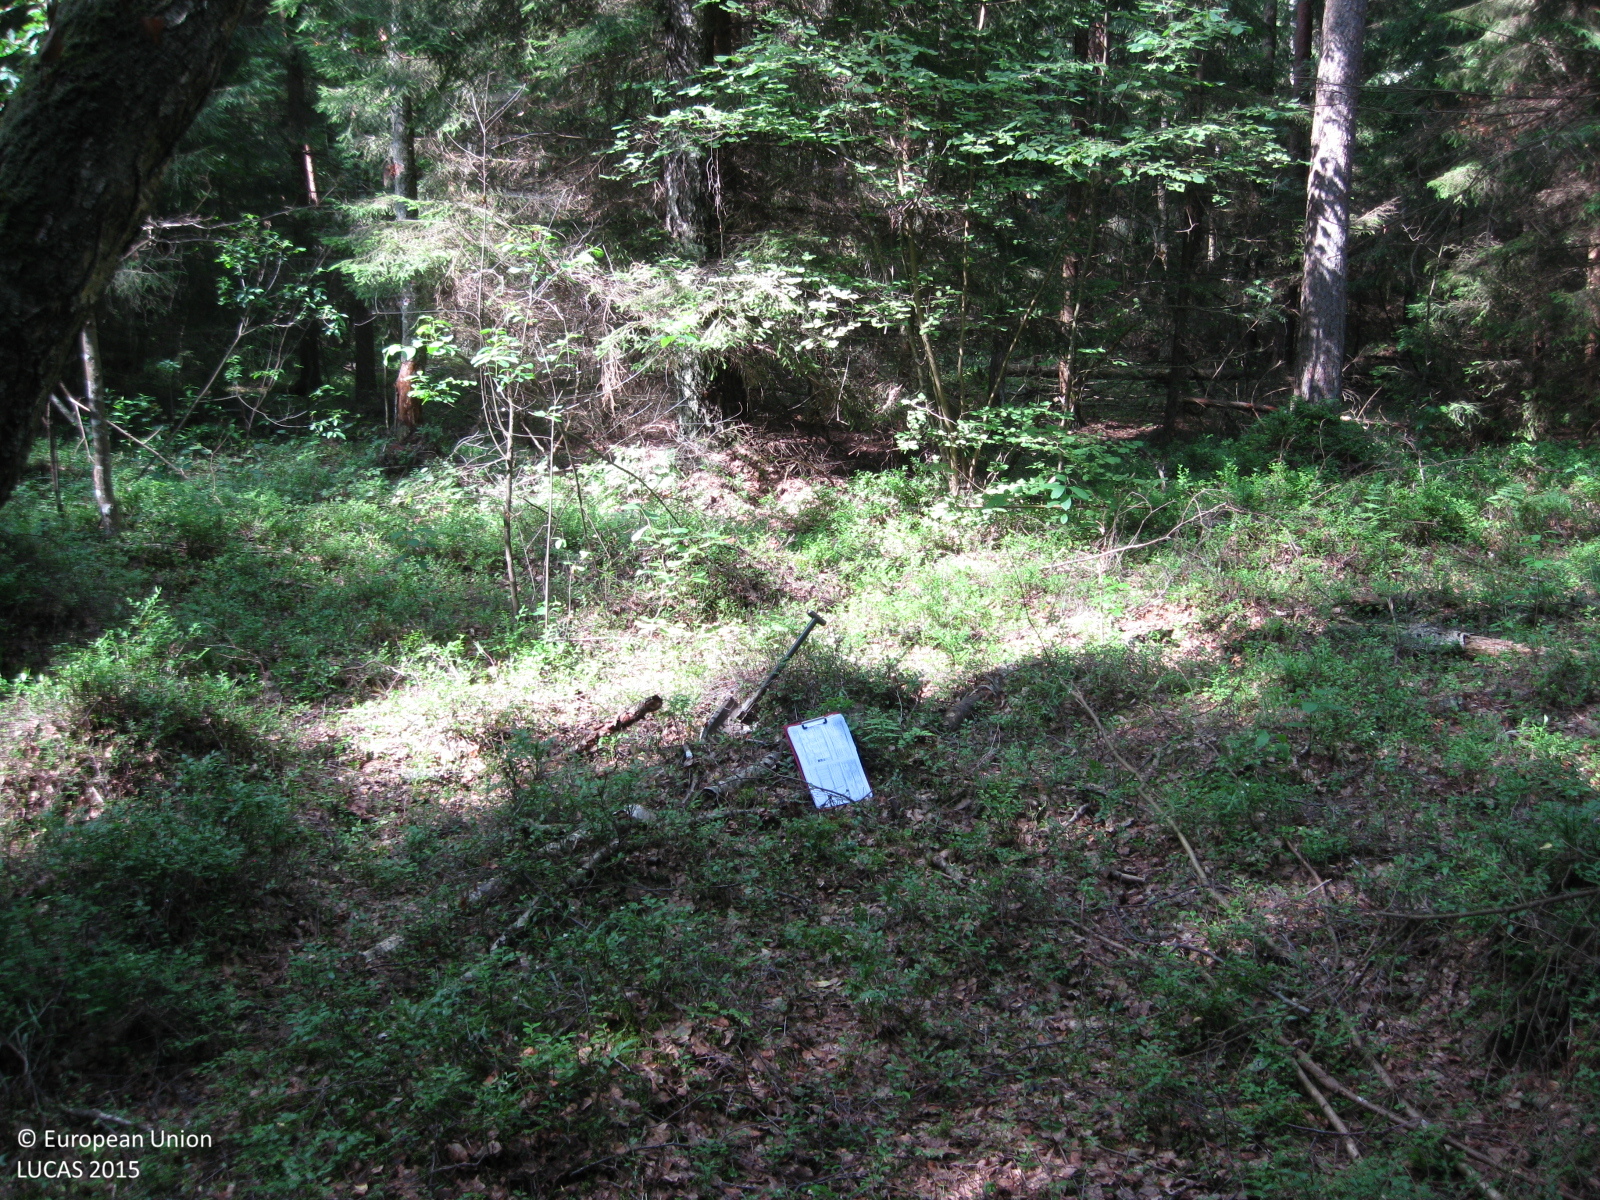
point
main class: Woodland
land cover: Other mixed woodland
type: hemiboreal forest and nemoral coniferous forest and mixed broadleaved-coniferous forest
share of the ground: > 75 %
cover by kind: coniferous forest trees 50 %, broadleaved forest trees 30 %, shrubs 10 %, lichens and mosses 10 %
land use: Forestry
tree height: > 5 m
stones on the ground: < 10 %
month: July
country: LT
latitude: 55.5574
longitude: 24.6735
